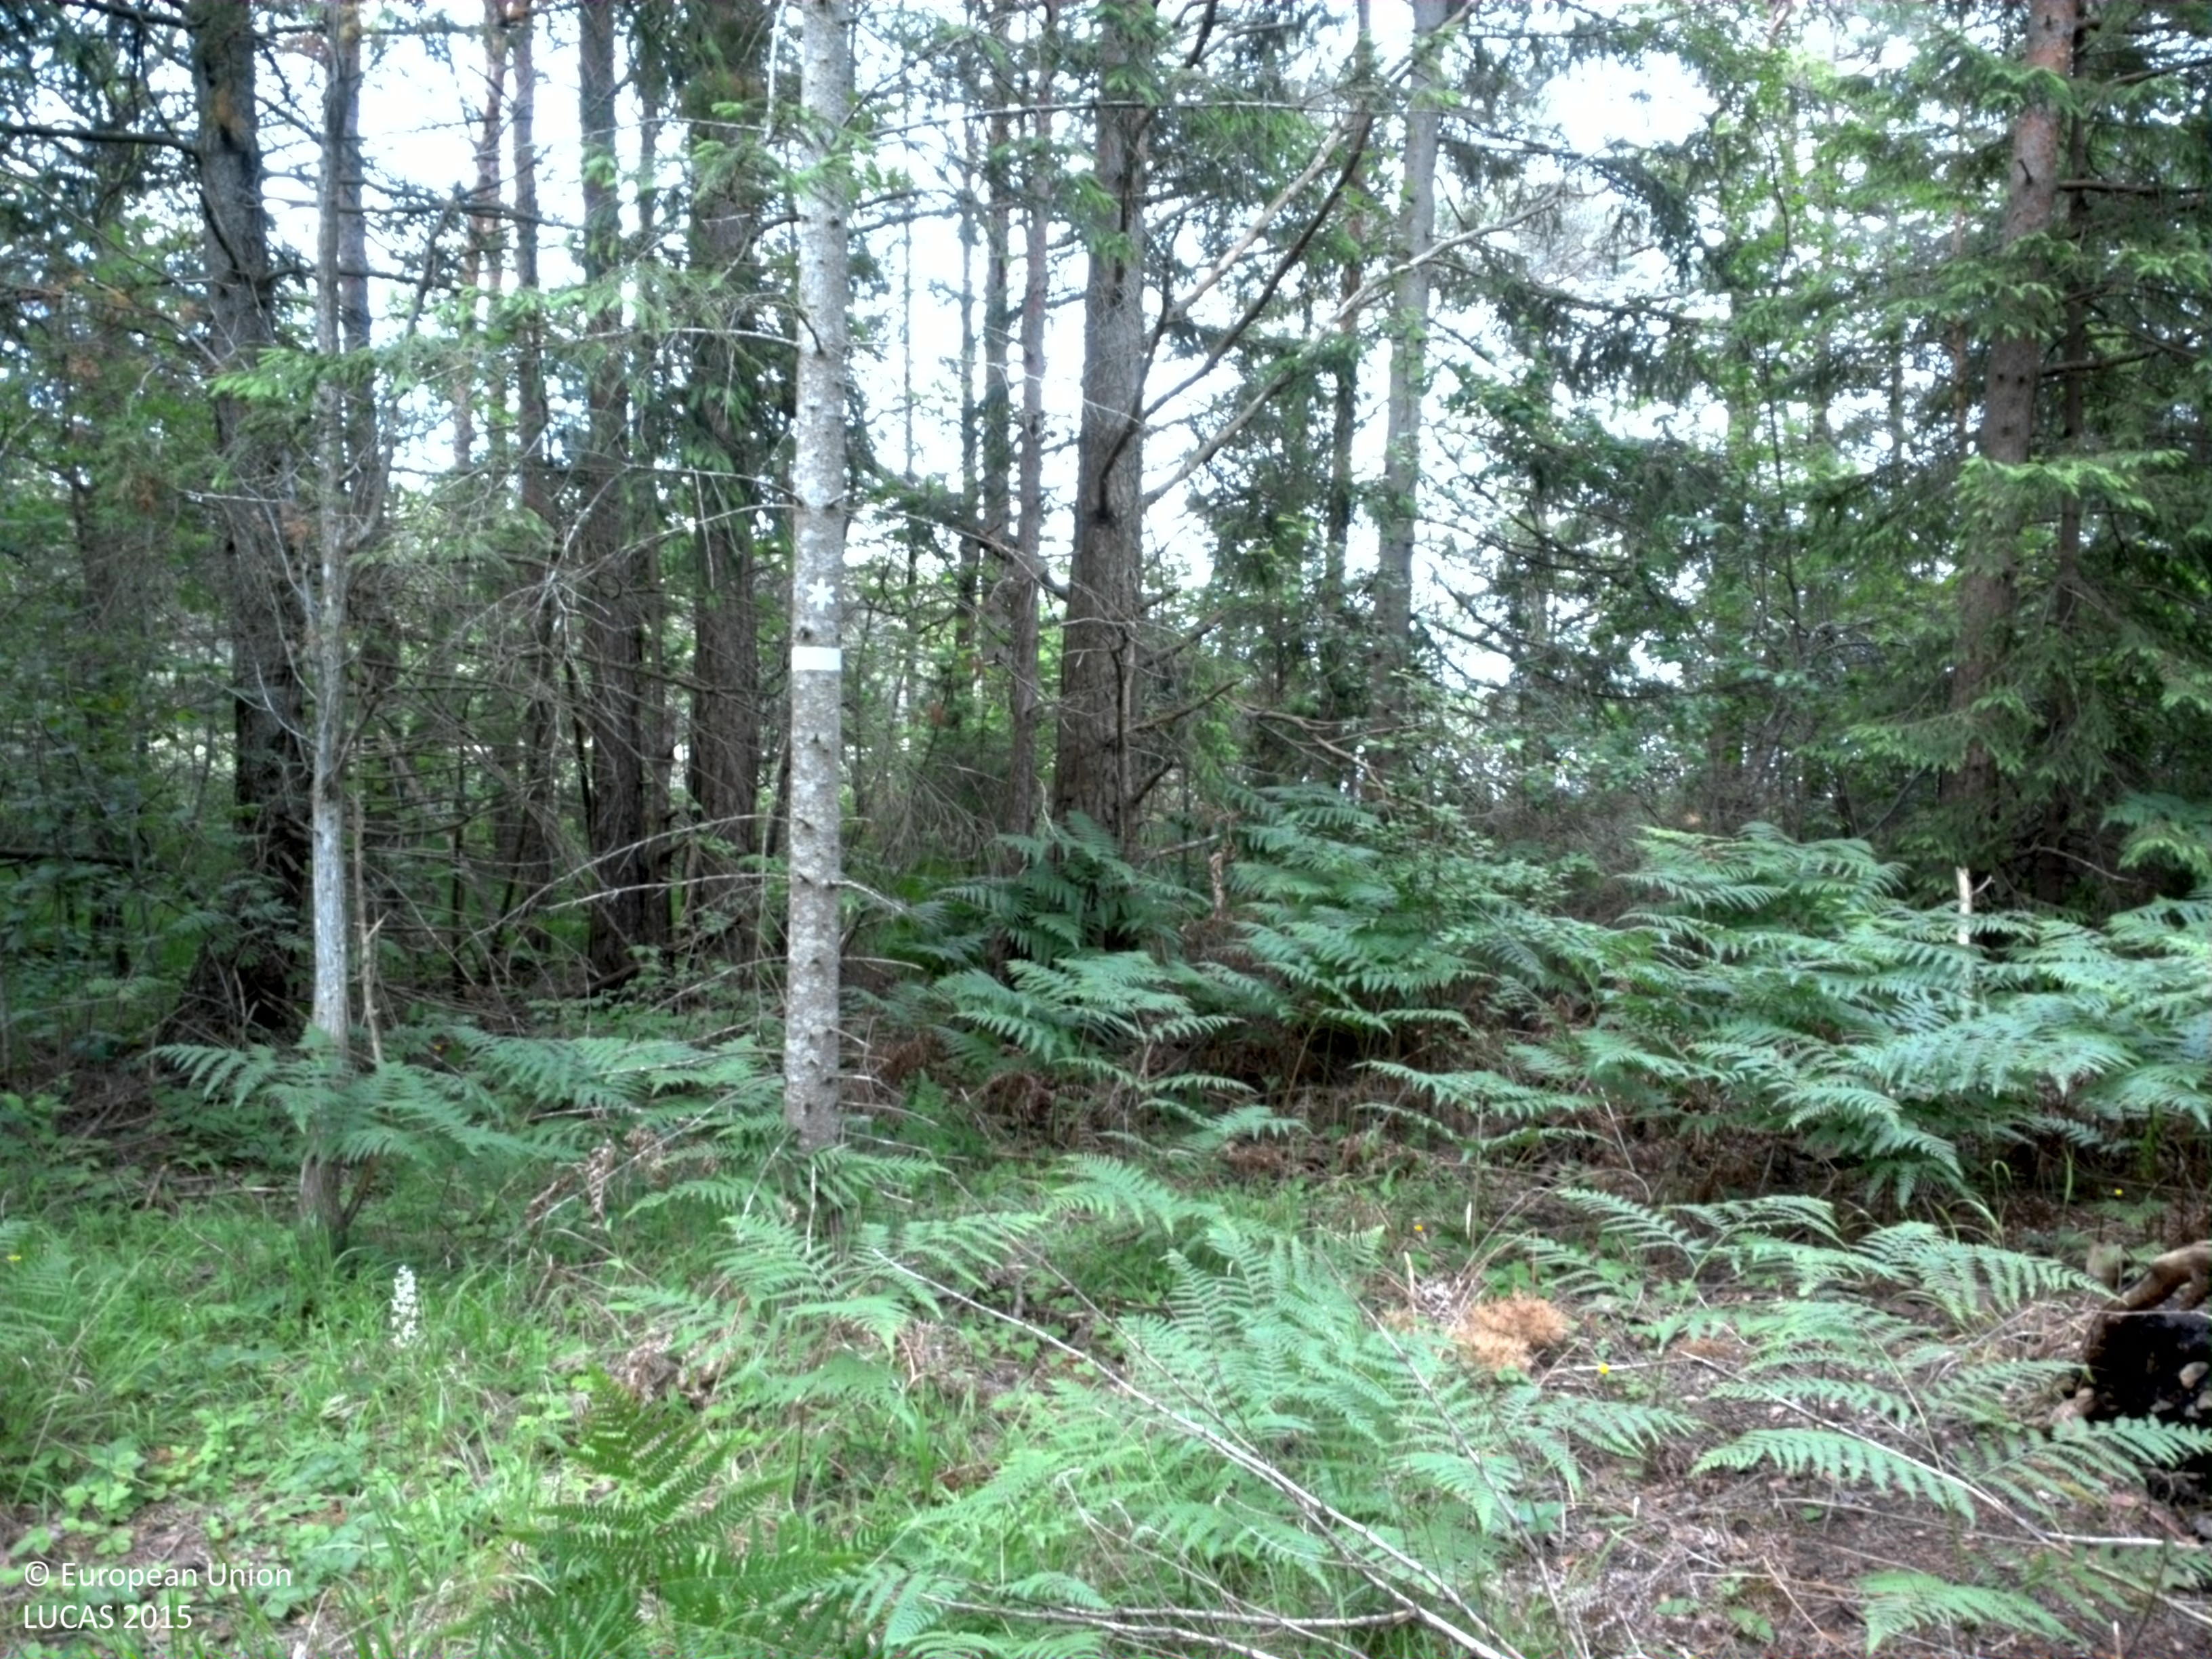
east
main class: Woodland
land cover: Pine dominated coniferous woodland
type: hemiboreal forest and nemoral coniferous forest and mixed broadleaved-coniferous forest
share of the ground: > 75 %
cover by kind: coniferous forest trees 70 %, herbaceous plants 15 %, shrubs 10 %, broadleaved forest trees 5 %
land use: Forestry
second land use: Amenities, museums, leisure
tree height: > 5 m
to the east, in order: Pine dominated coniferous woodland; Inland fresh water bodies
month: June
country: SE
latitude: 57.8744
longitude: 18.8274
